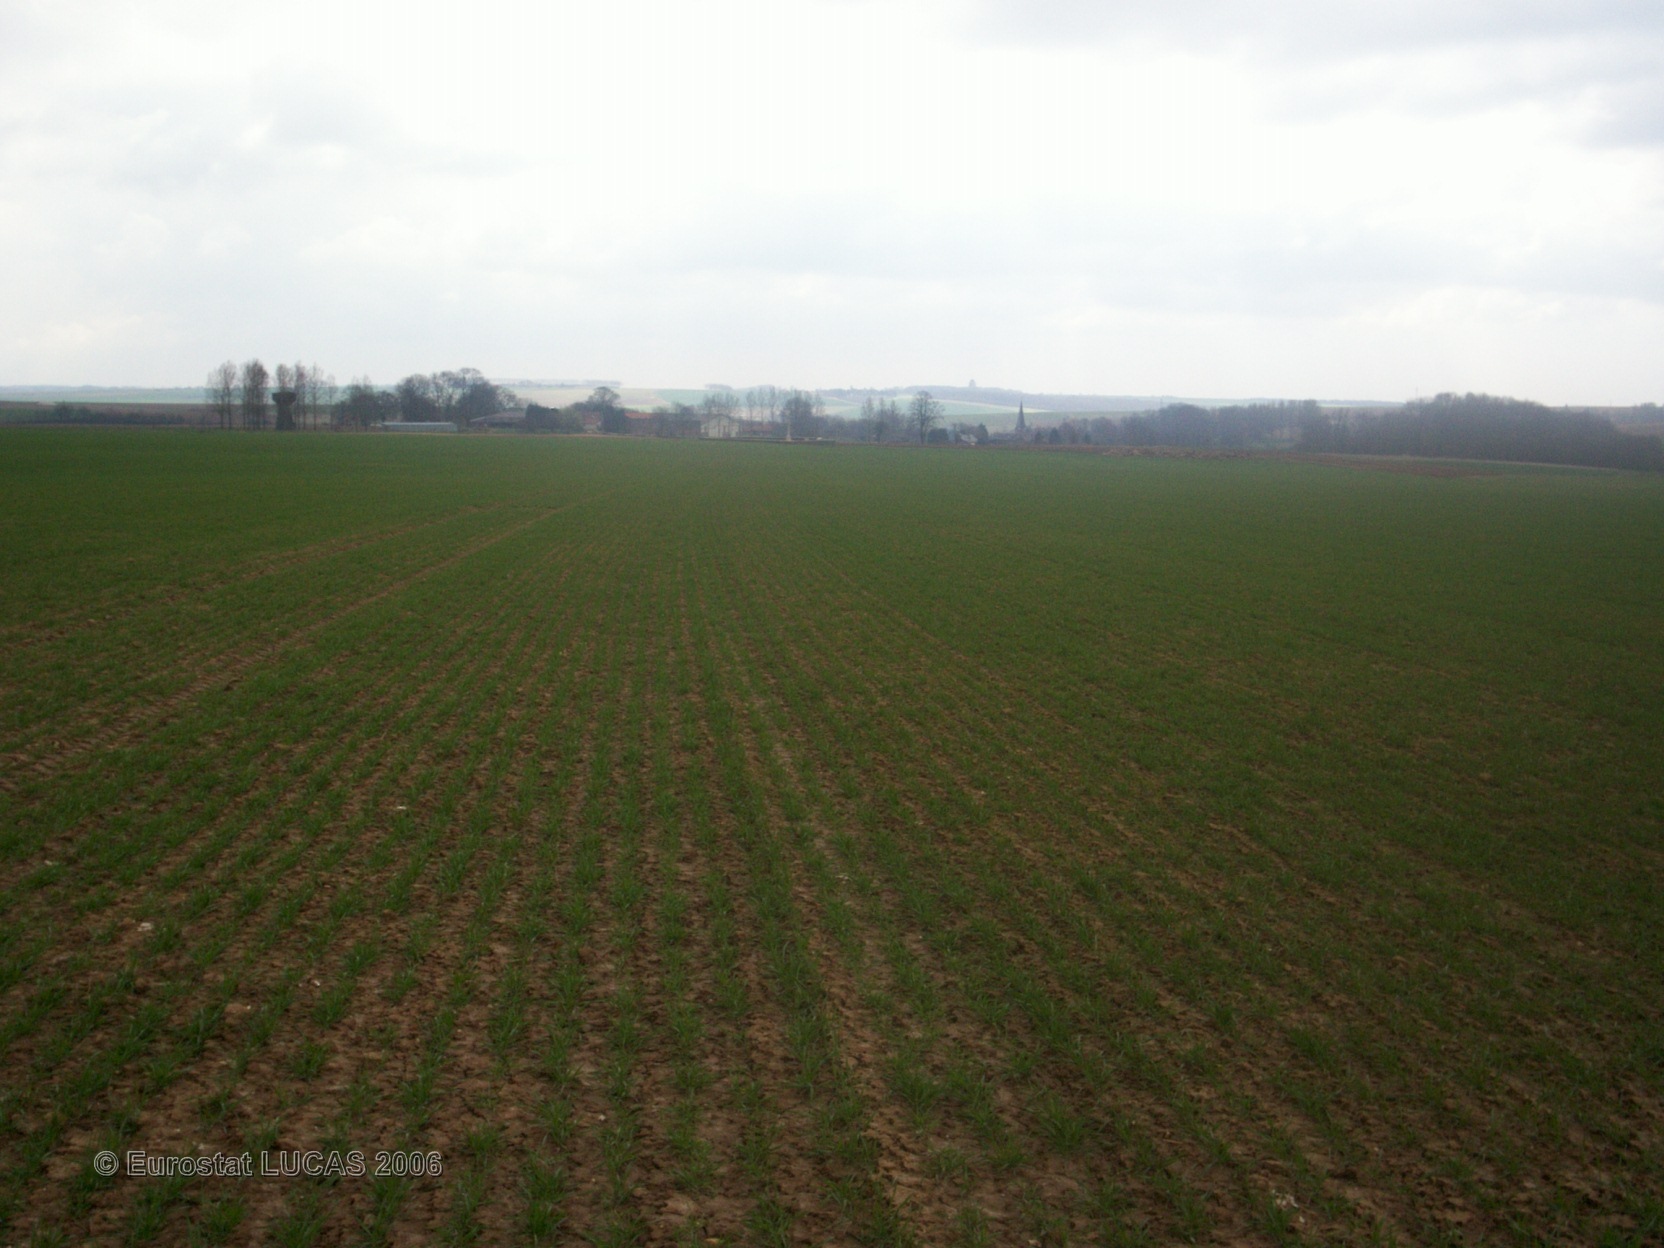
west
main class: Cropland
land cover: Common wheat
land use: Agriculture (excluding fallow land and kitchen gardens)
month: April
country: FR
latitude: 50.0913
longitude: 2.6501
